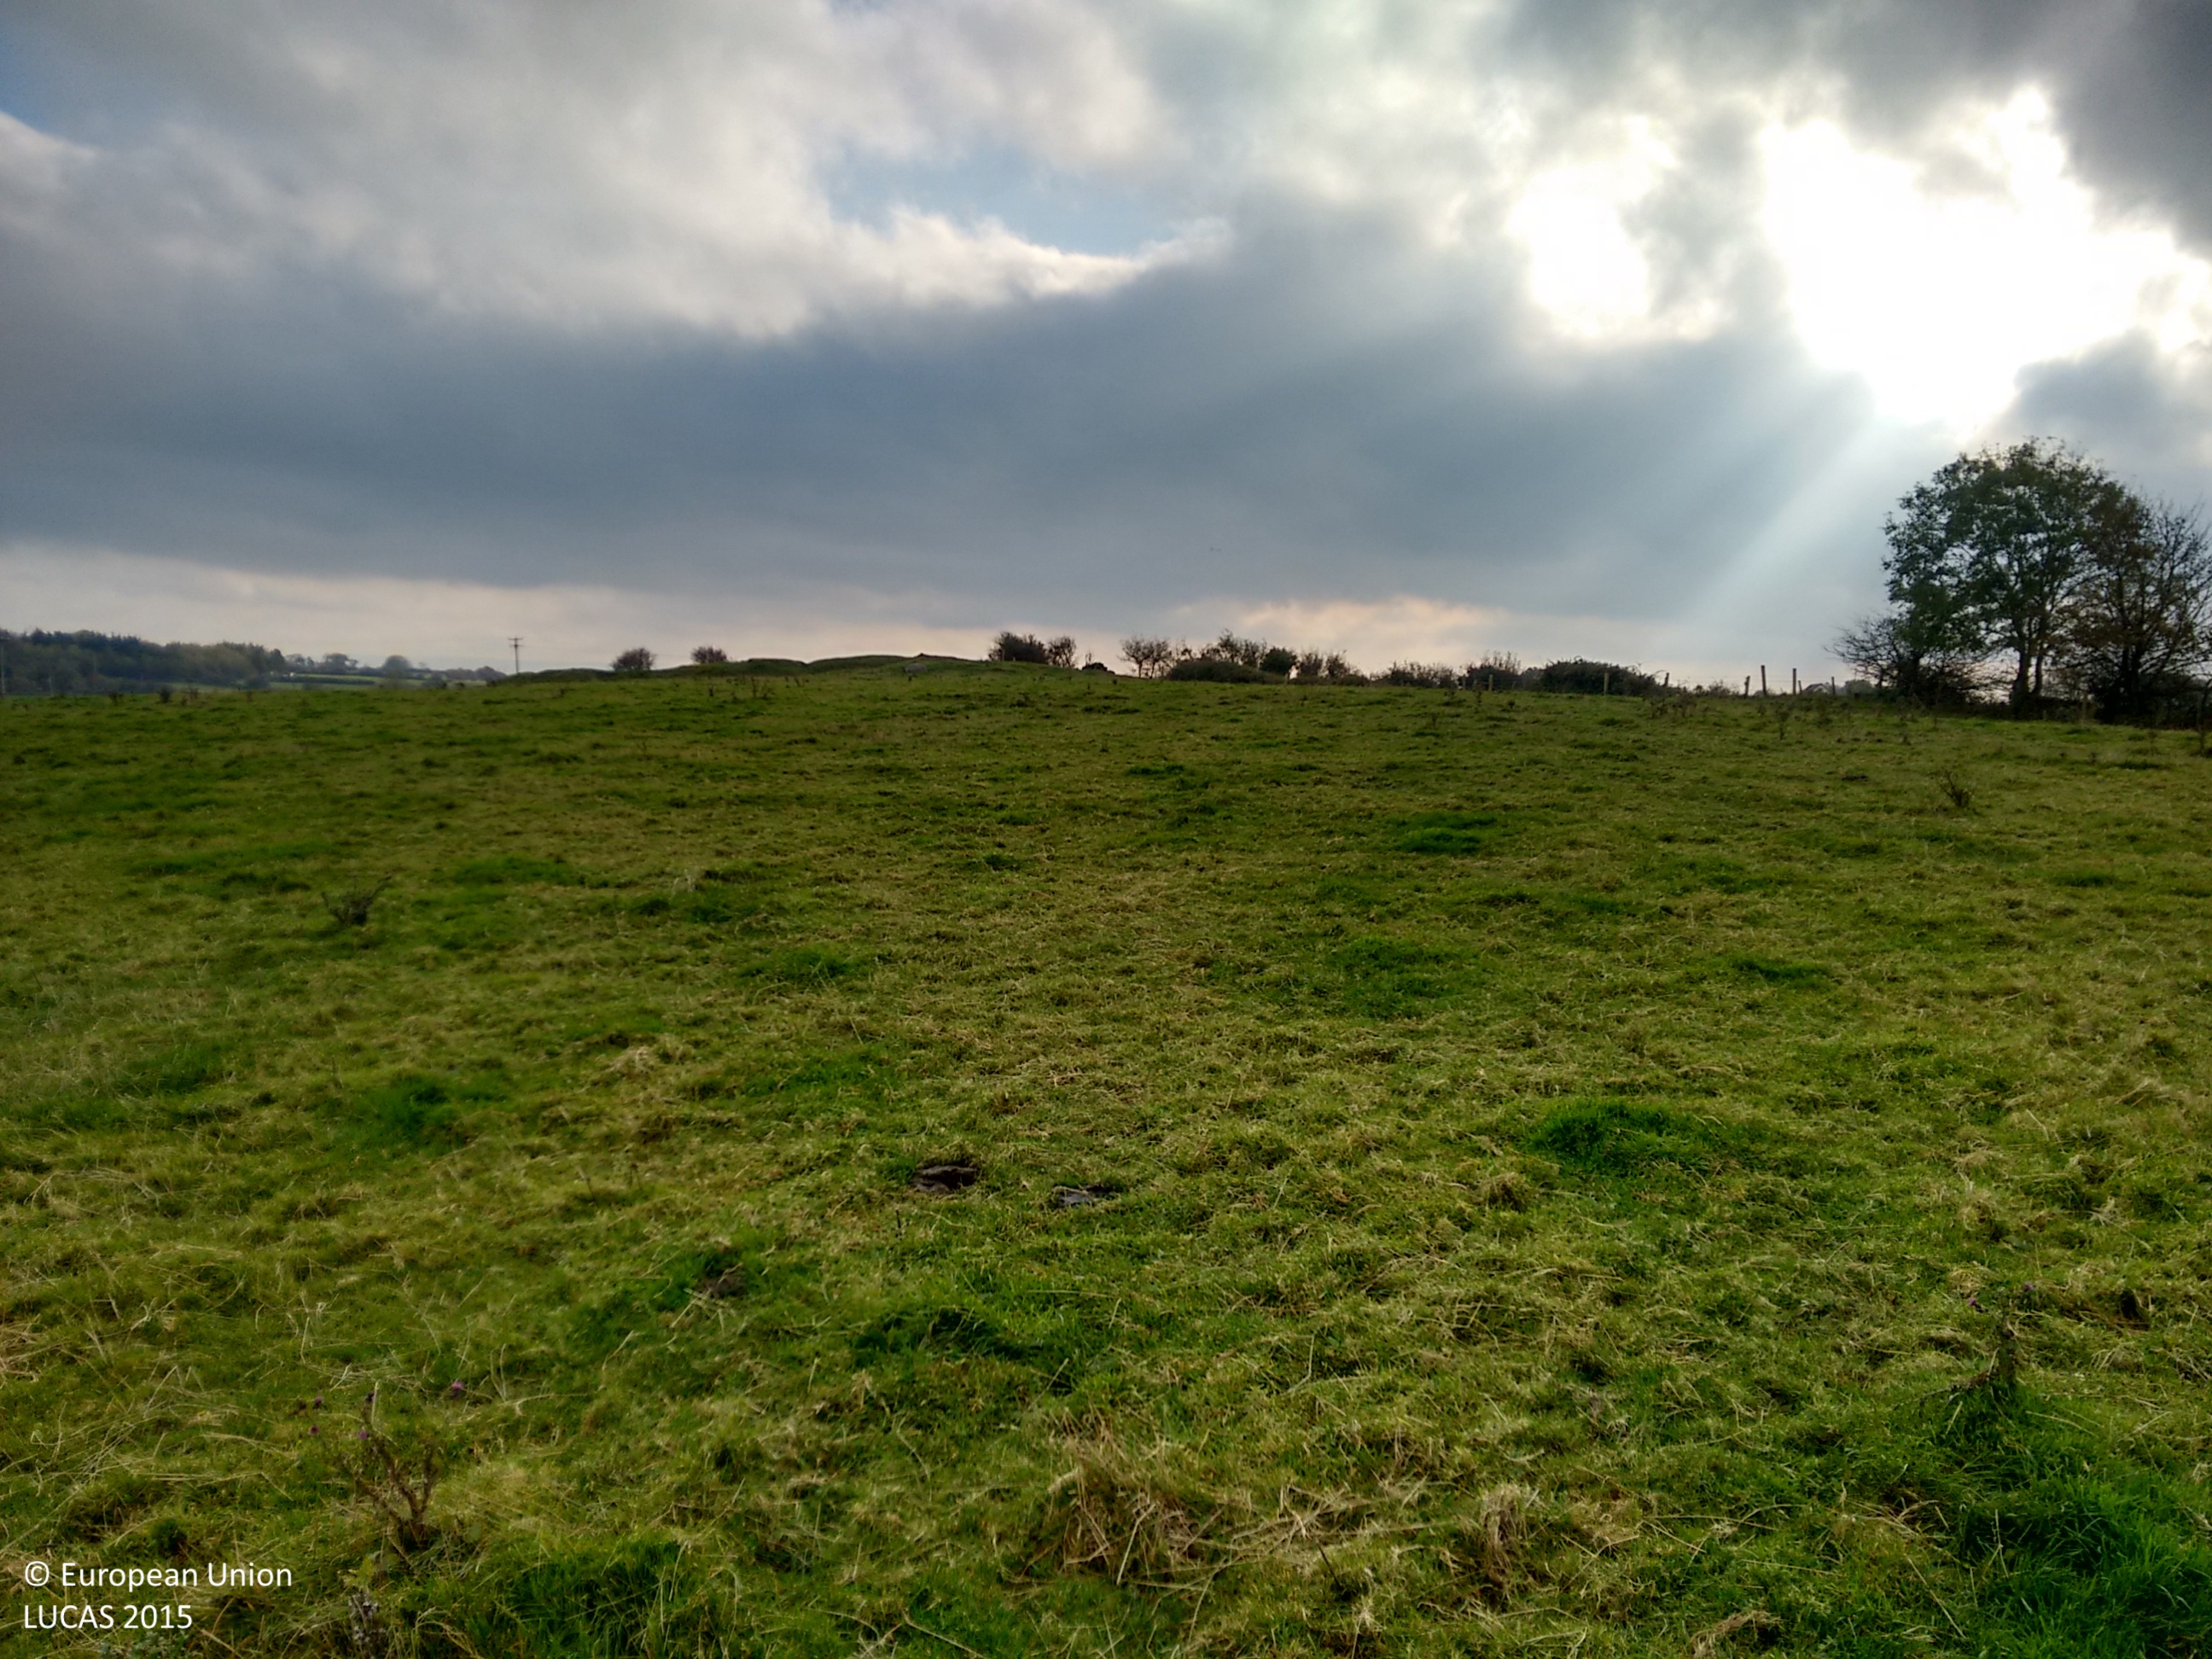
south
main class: Grassland
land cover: Grassland without tree/shrub cover
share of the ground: > 75 %
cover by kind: herbaceous plants 100 %
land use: Agriculture (excluding fallow land and kitchen gardens)
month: November
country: IE
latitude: 54.1916
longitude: -9.1127
